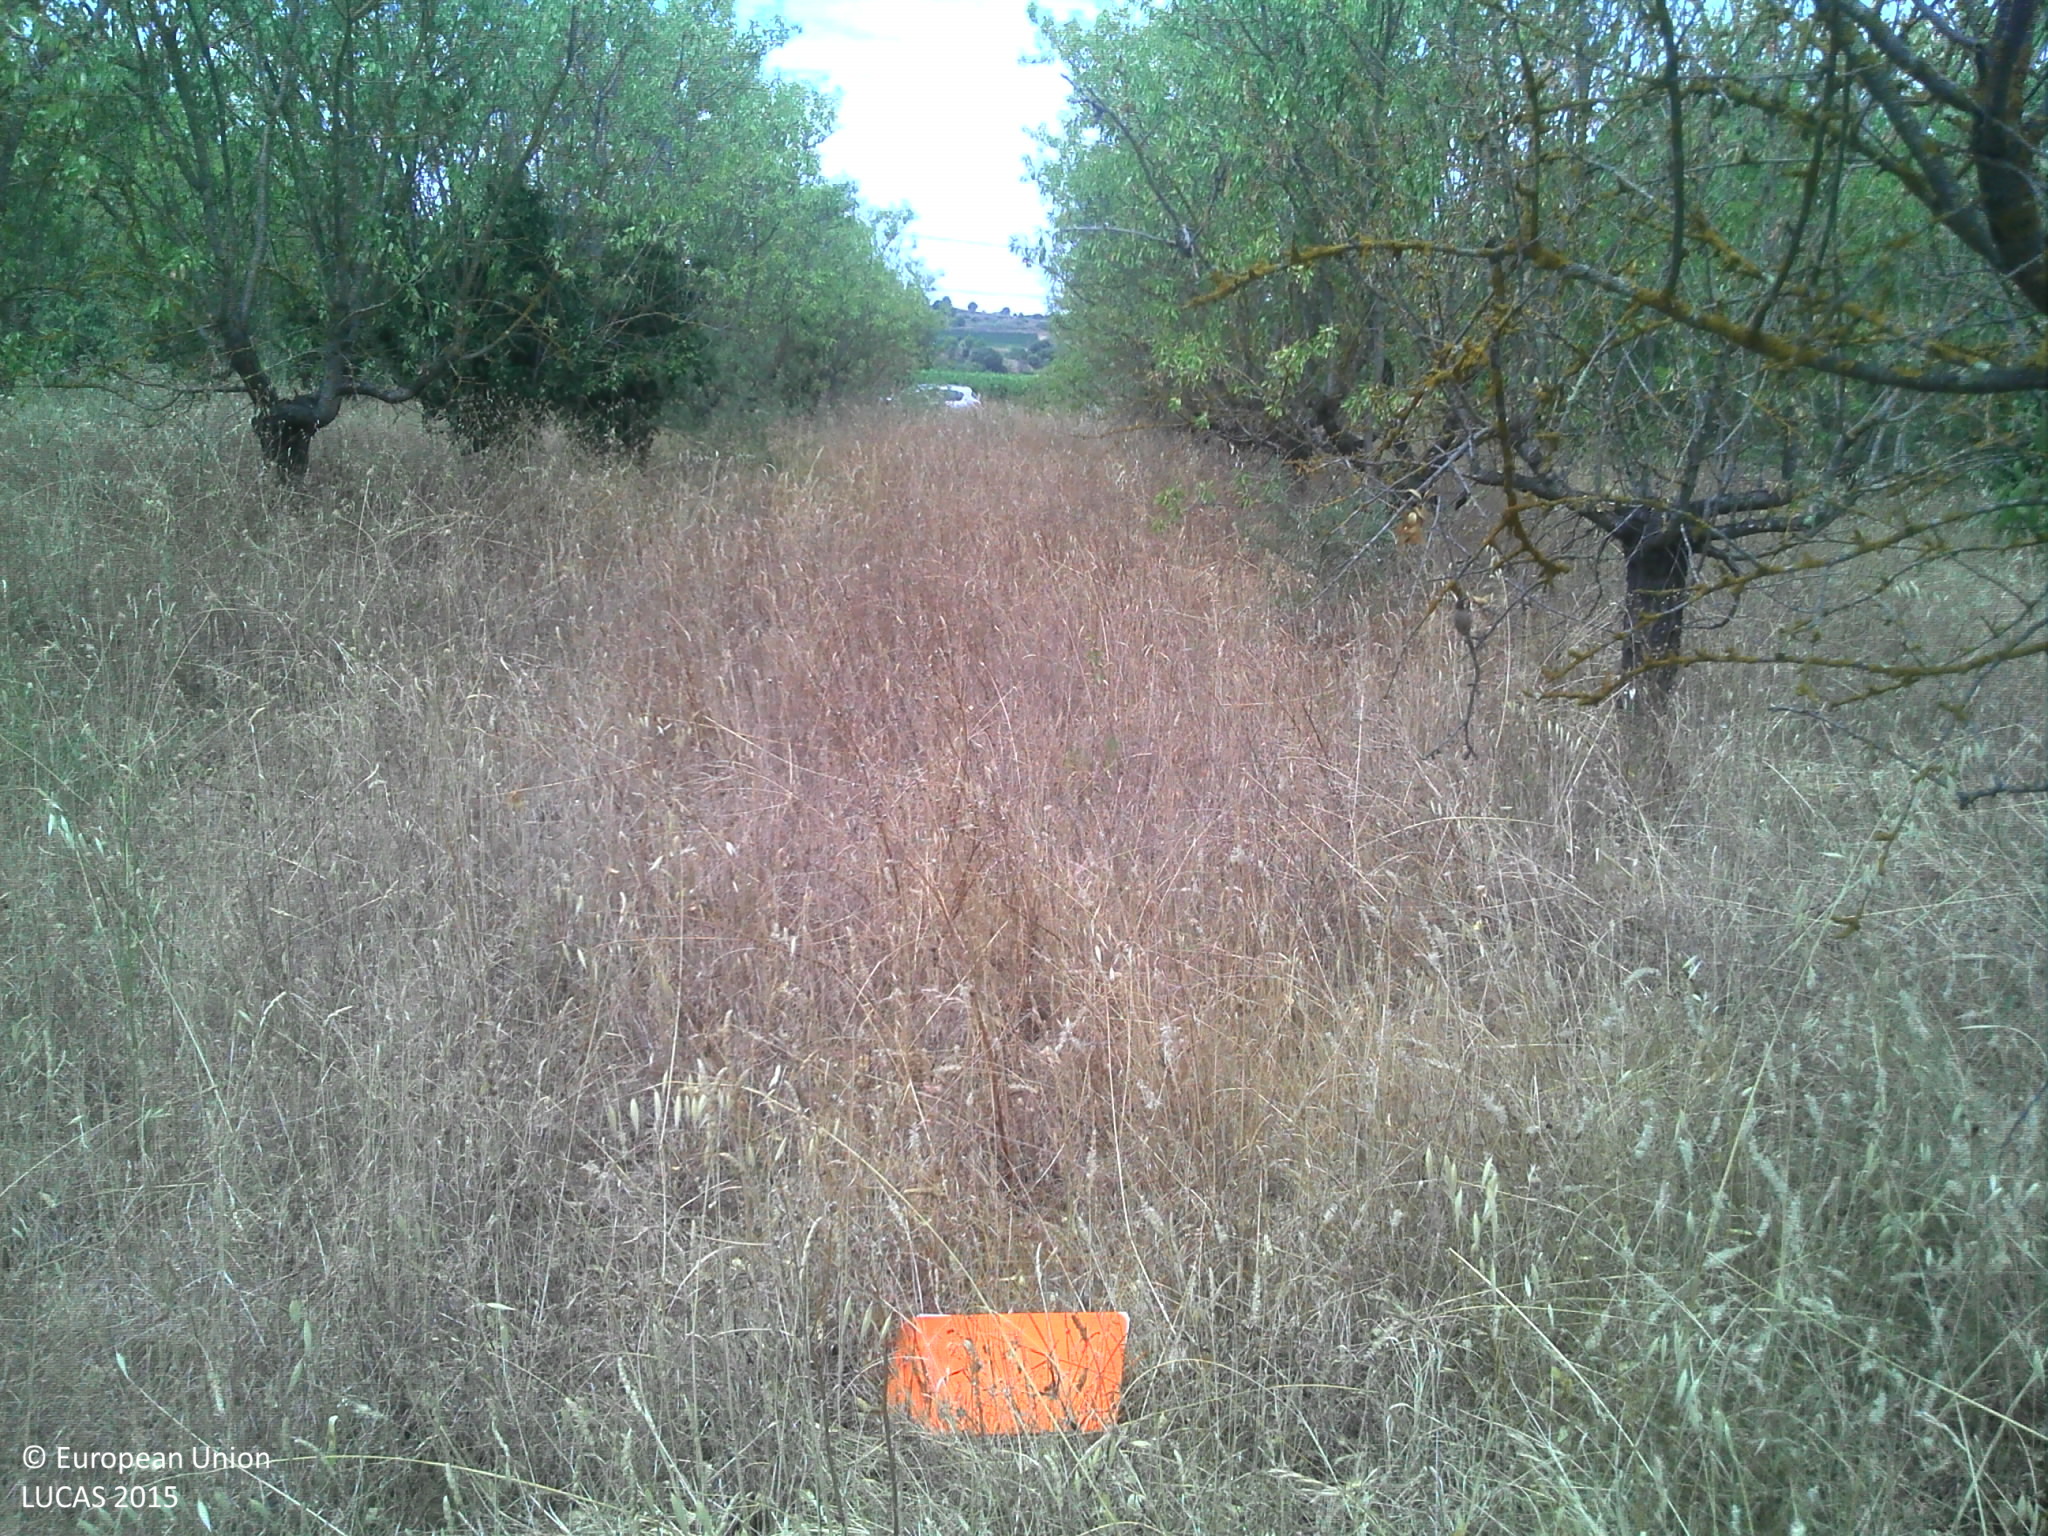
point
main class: Cropland
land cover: Other fruit trees and berries
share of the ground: 50 - 75 %
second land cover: Grassland without tree/shrub cover
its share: 50 - 75 %
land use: Agriculture (excluding fallow land and kitchen gardens)
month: July
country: FR
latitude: 43.3825
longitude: 3.1585
